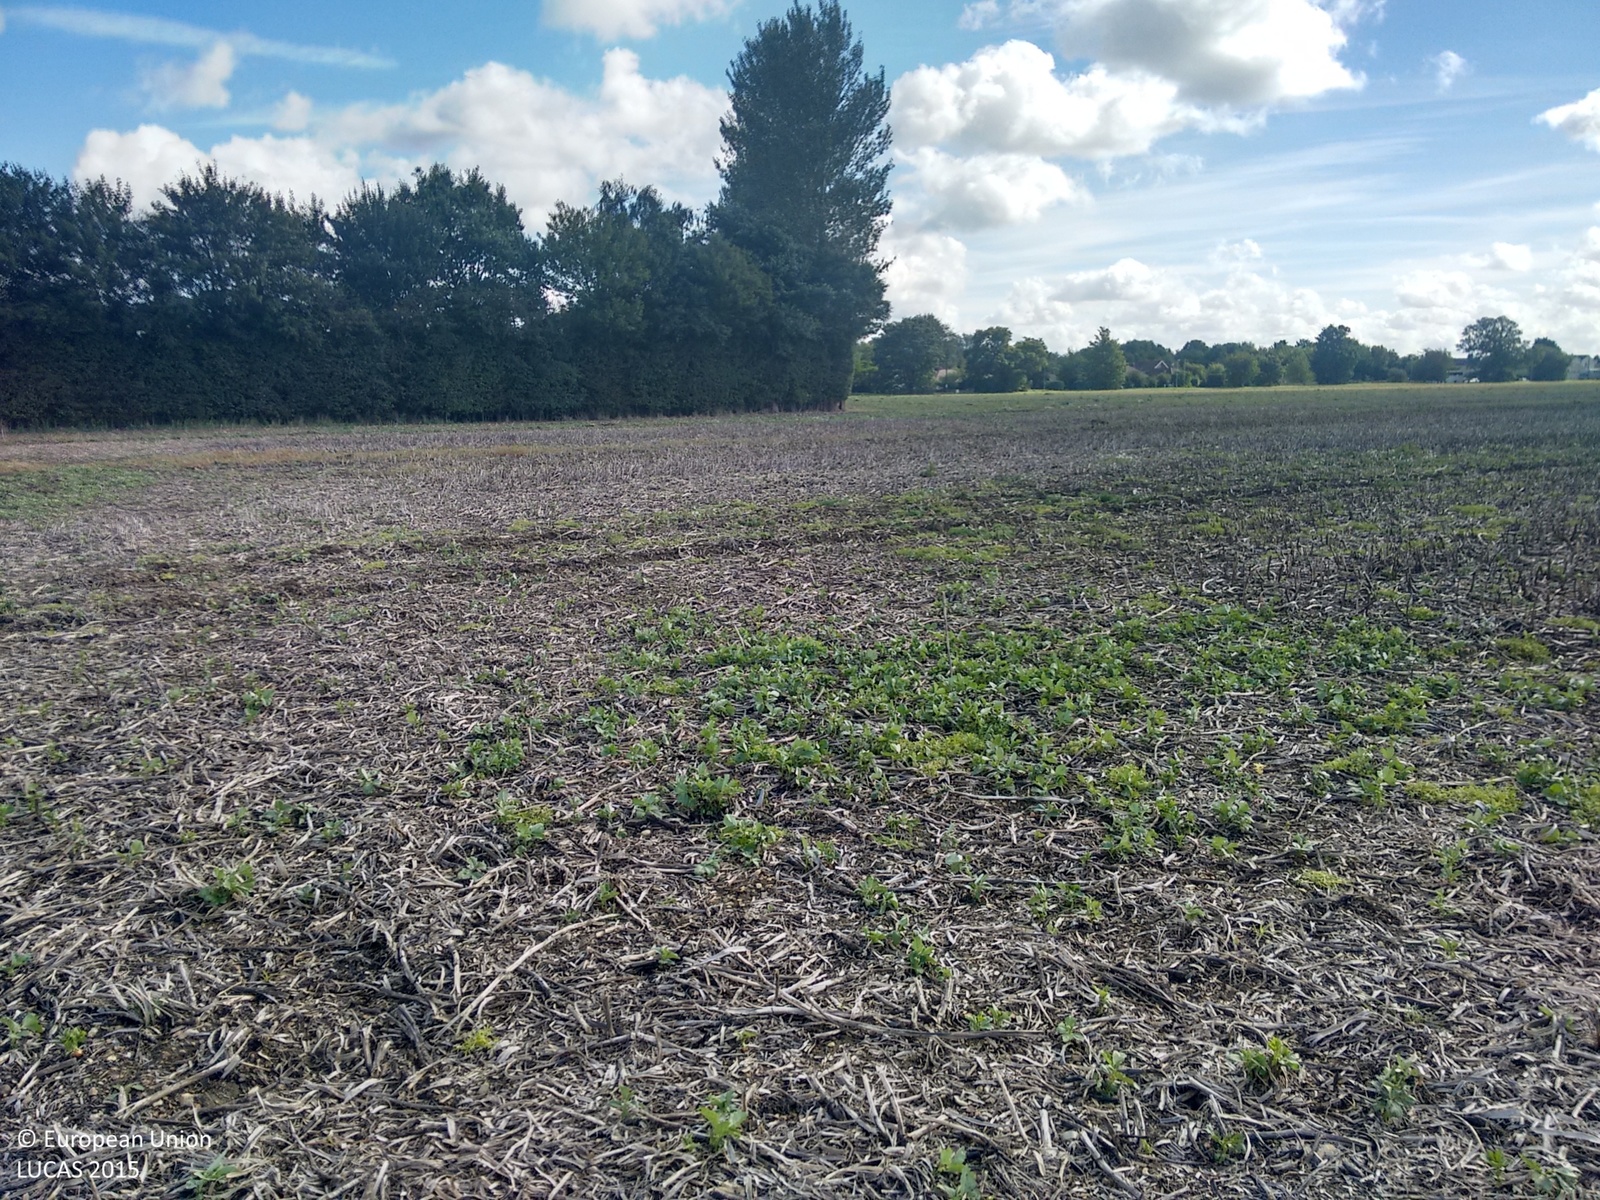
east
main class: Cropland
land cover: Dry pulses
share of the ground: 50 - 75 %
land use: Agriculture (excluding fallow land and kitchen gardens)
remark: Harvested field
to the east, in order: Dry pulses; Managed hedges; Grassland with sparse tree/shrub cover; Broadleaved woodland; Managed hedges; Grass margins; Artificial constructions in urban areas
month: September
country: GB
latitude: 52.1216
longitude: 0.0507
